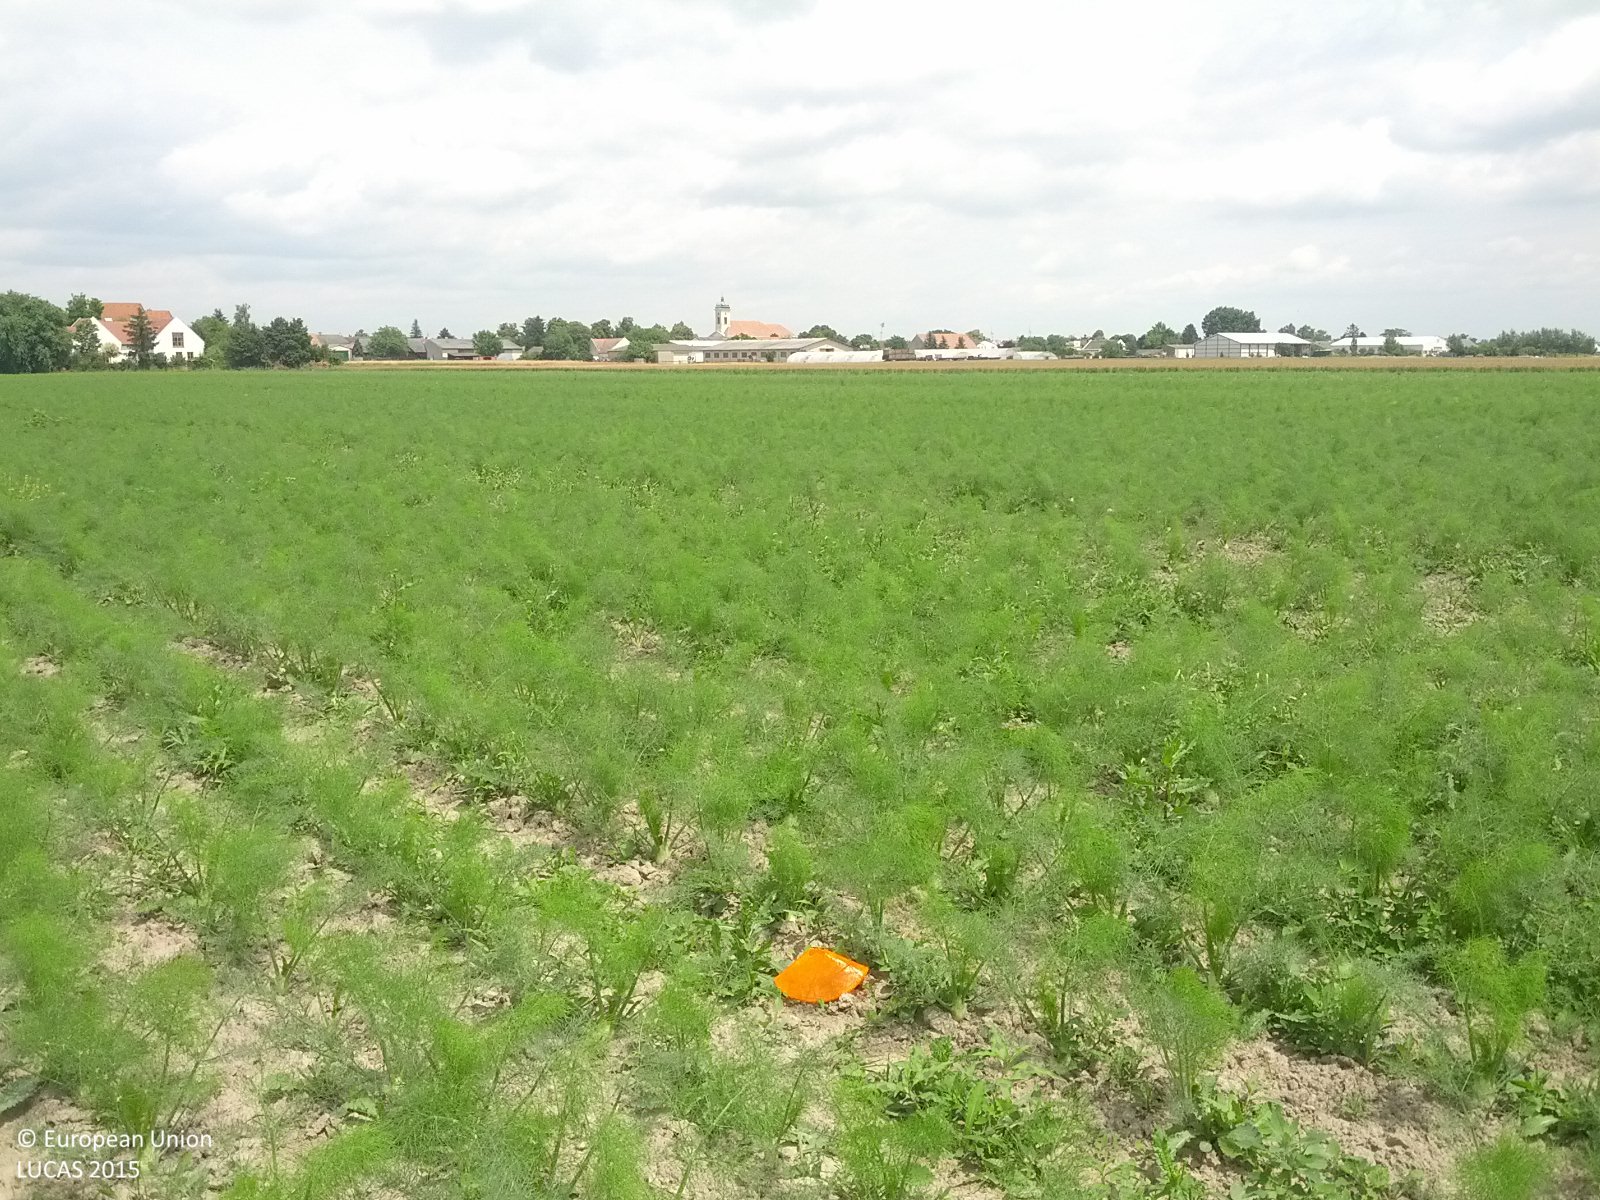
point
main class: Cropland
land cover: Other non-permanent industrial crops
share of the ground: > 75 %
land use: Agriculture (excluding fallow land and kitchen gardens)
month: June
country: AT
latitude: 48.1860
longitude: 16.6373
